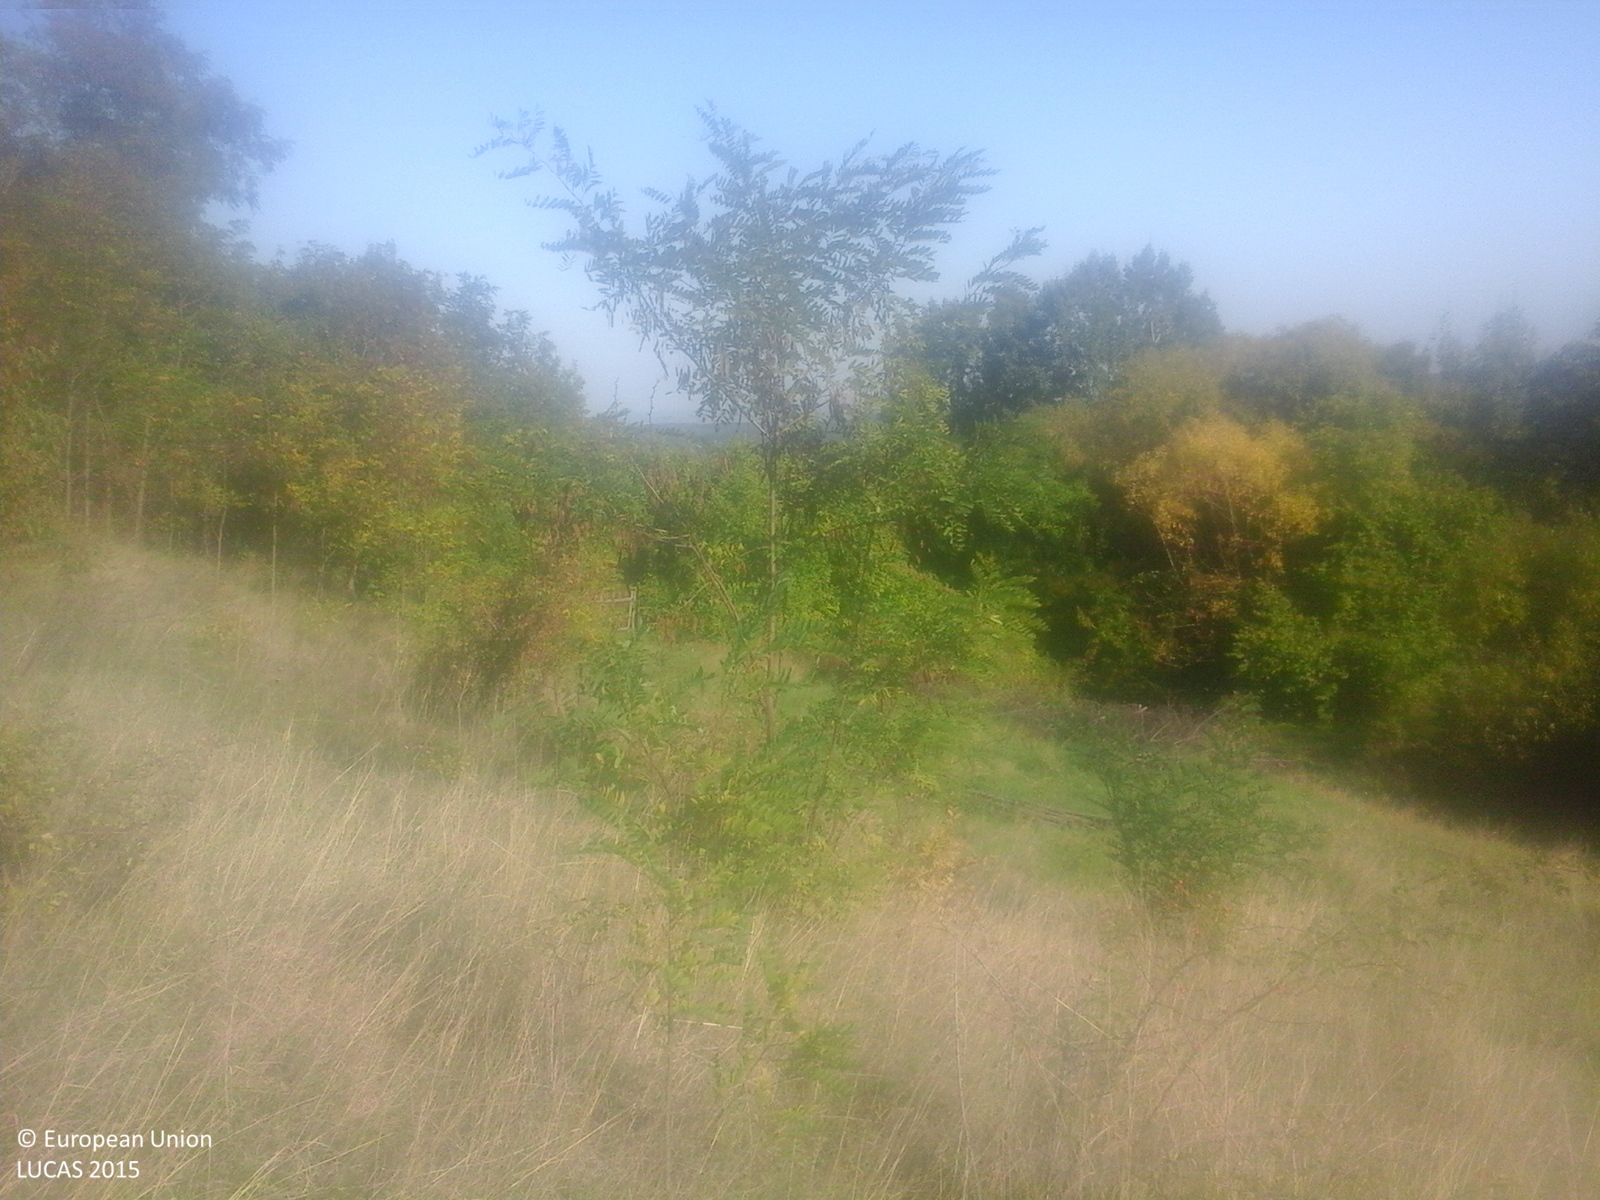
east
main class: Grassland
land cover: Grassland with sparse tree/shrub cover
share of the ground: > 75 %
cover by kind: herbaceous plants 85 %, shrubs 10 %, broadleaved forest trees 5 %
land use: Agriculture (excluding fallow land and kitchen gardens)
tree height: < 5 m
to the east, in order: Grassland with sparse tree/shrub cover; Shrubland with sparse tree cover; Tracks; Abandoned hedges; Rivers and streams; Broadleaved woodland; Permanent crops (only in case pi)
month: October
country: RO
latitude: 46.4603
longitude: 23.6243
